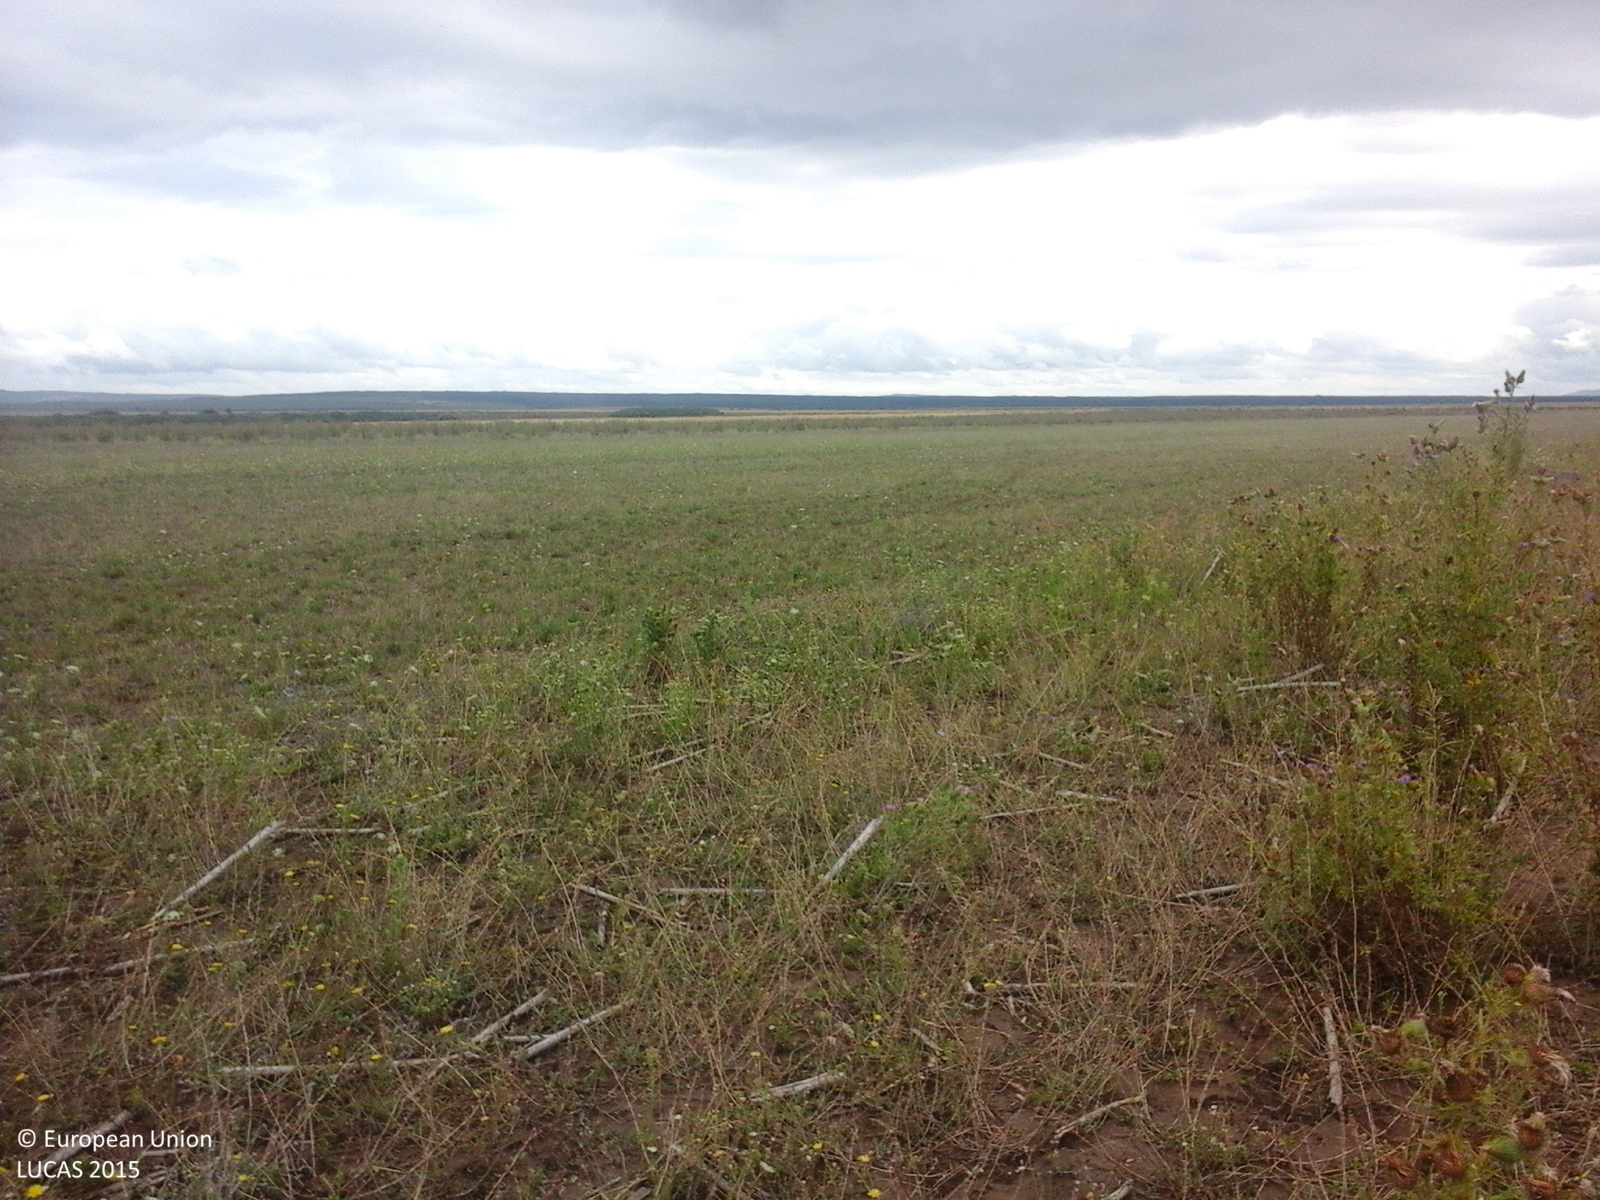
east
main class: Grassland
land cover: Spontaneously vegetated surfaces
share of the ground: > 75 %
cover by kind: herbaceous plants 100 %
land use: Agriculture (excluding fallow land and kitchen gardens)
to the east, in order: Spontaneously vegetated surfaces; Grassland without tree/shrub cover; Spontaneously vegetated surfaces
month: August
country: RO
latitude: 45.5623
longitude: 21.5251
